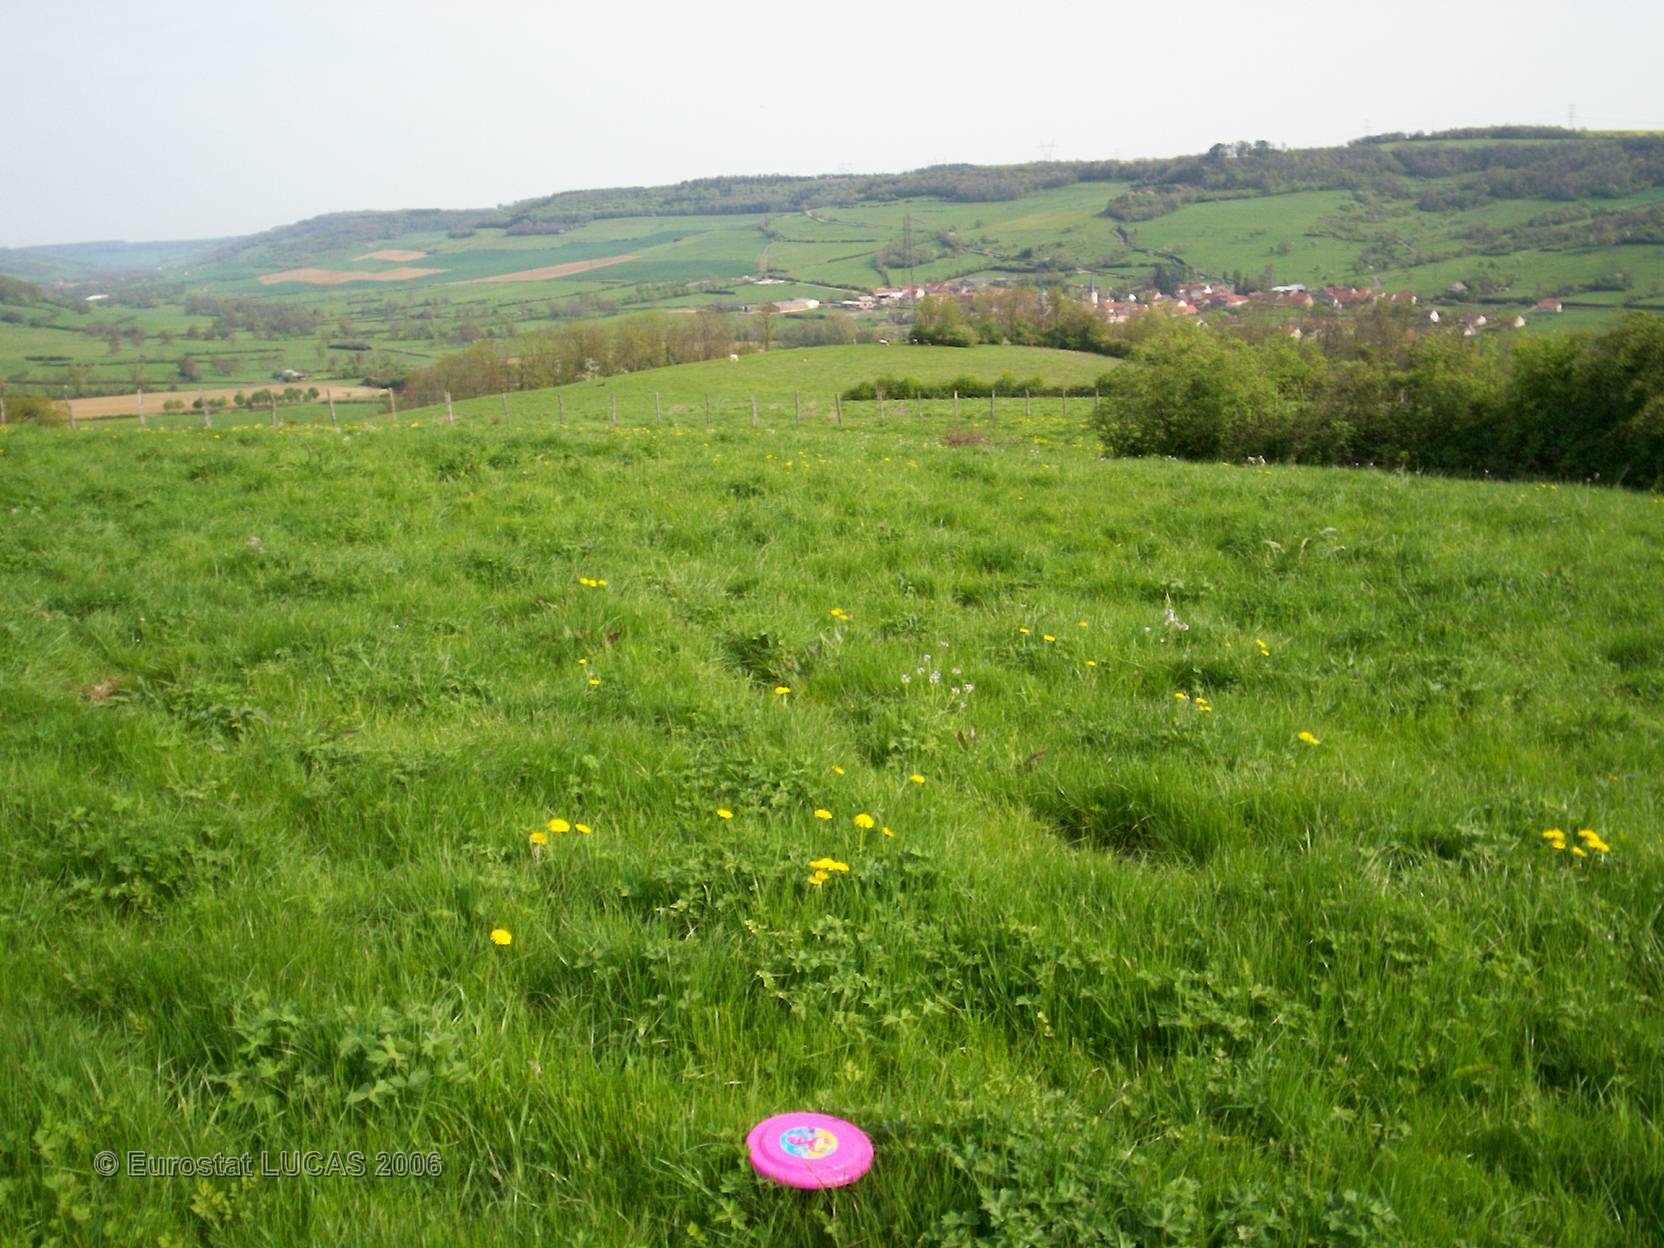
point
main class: Grassland
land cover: Grassland without tree/shrub cover
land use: Agriculture (excluding fallow land and kitchen gardens)
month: May
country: FR
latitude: 47.4074
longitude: 4.6325
